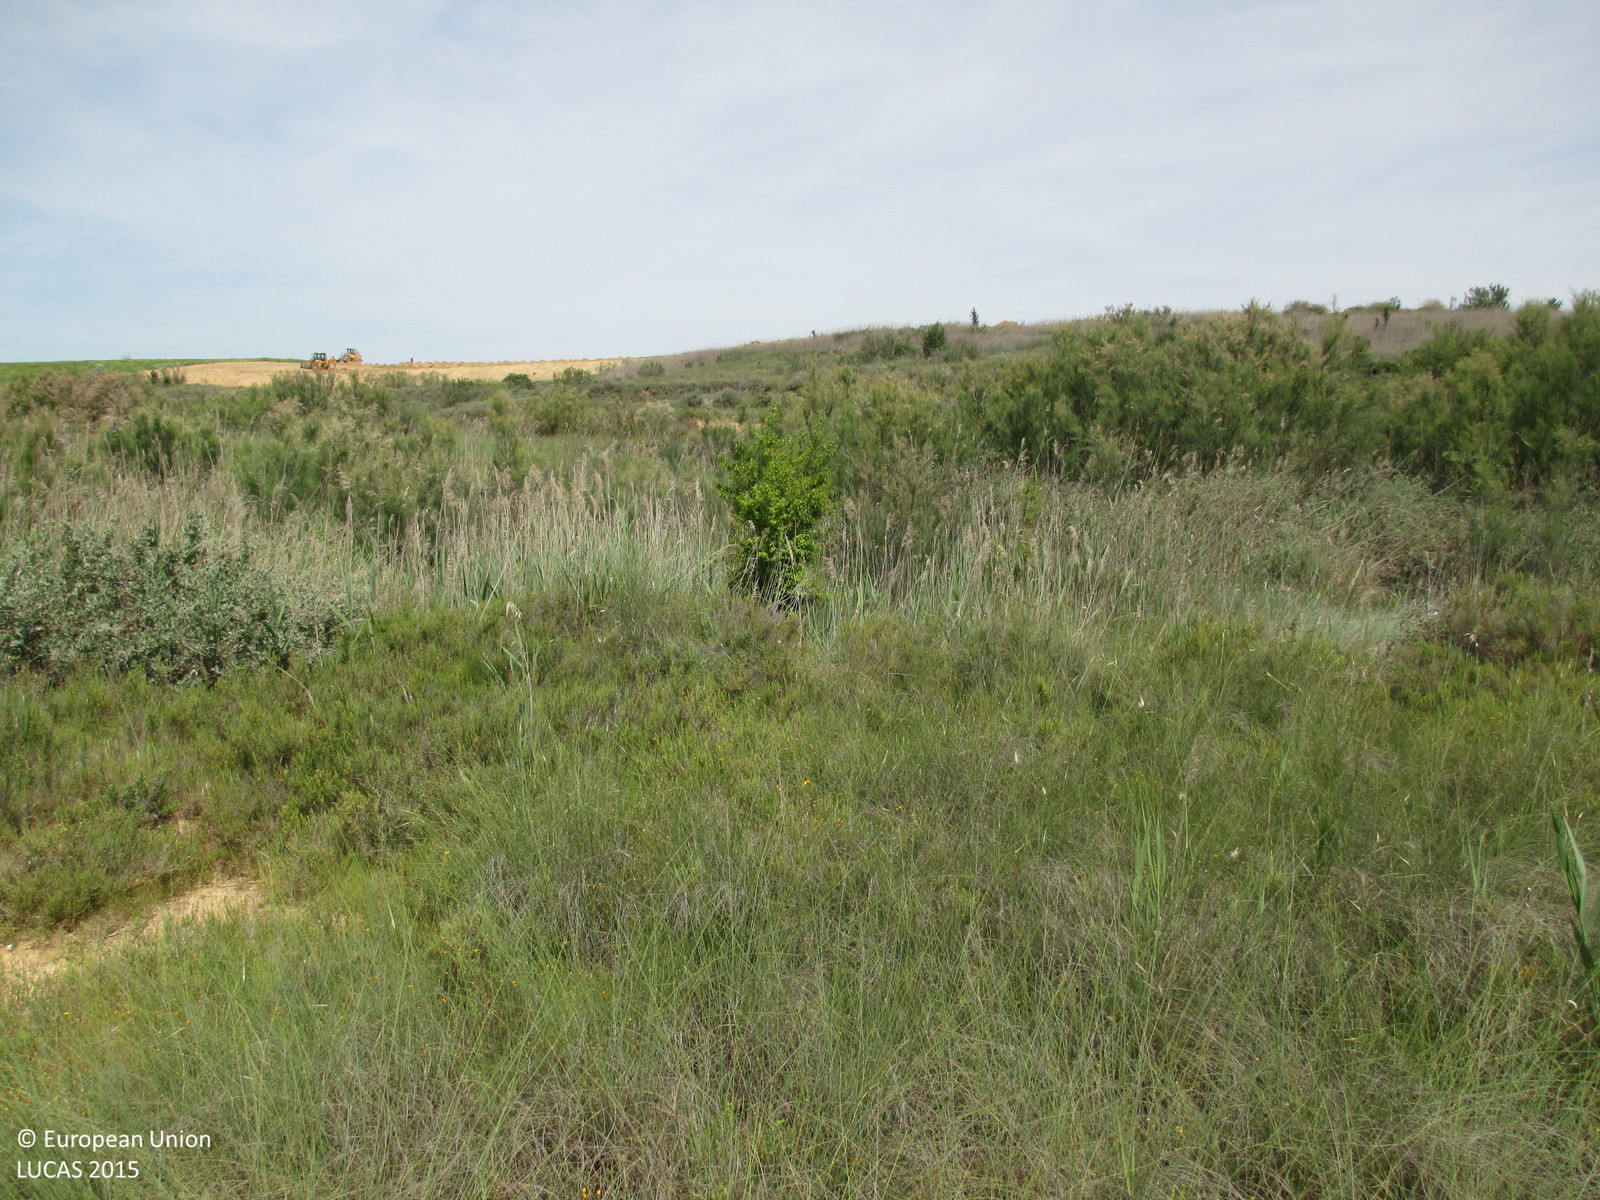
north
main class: Shrubland
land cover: Shrubland without tree cover
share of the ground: > 75 %
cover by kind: shrubs 95 %, herbaceous plants 5 %
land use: Semi-natural and natural areas not in use
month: May
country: ES
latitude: 41.8836
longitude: -0.3718
